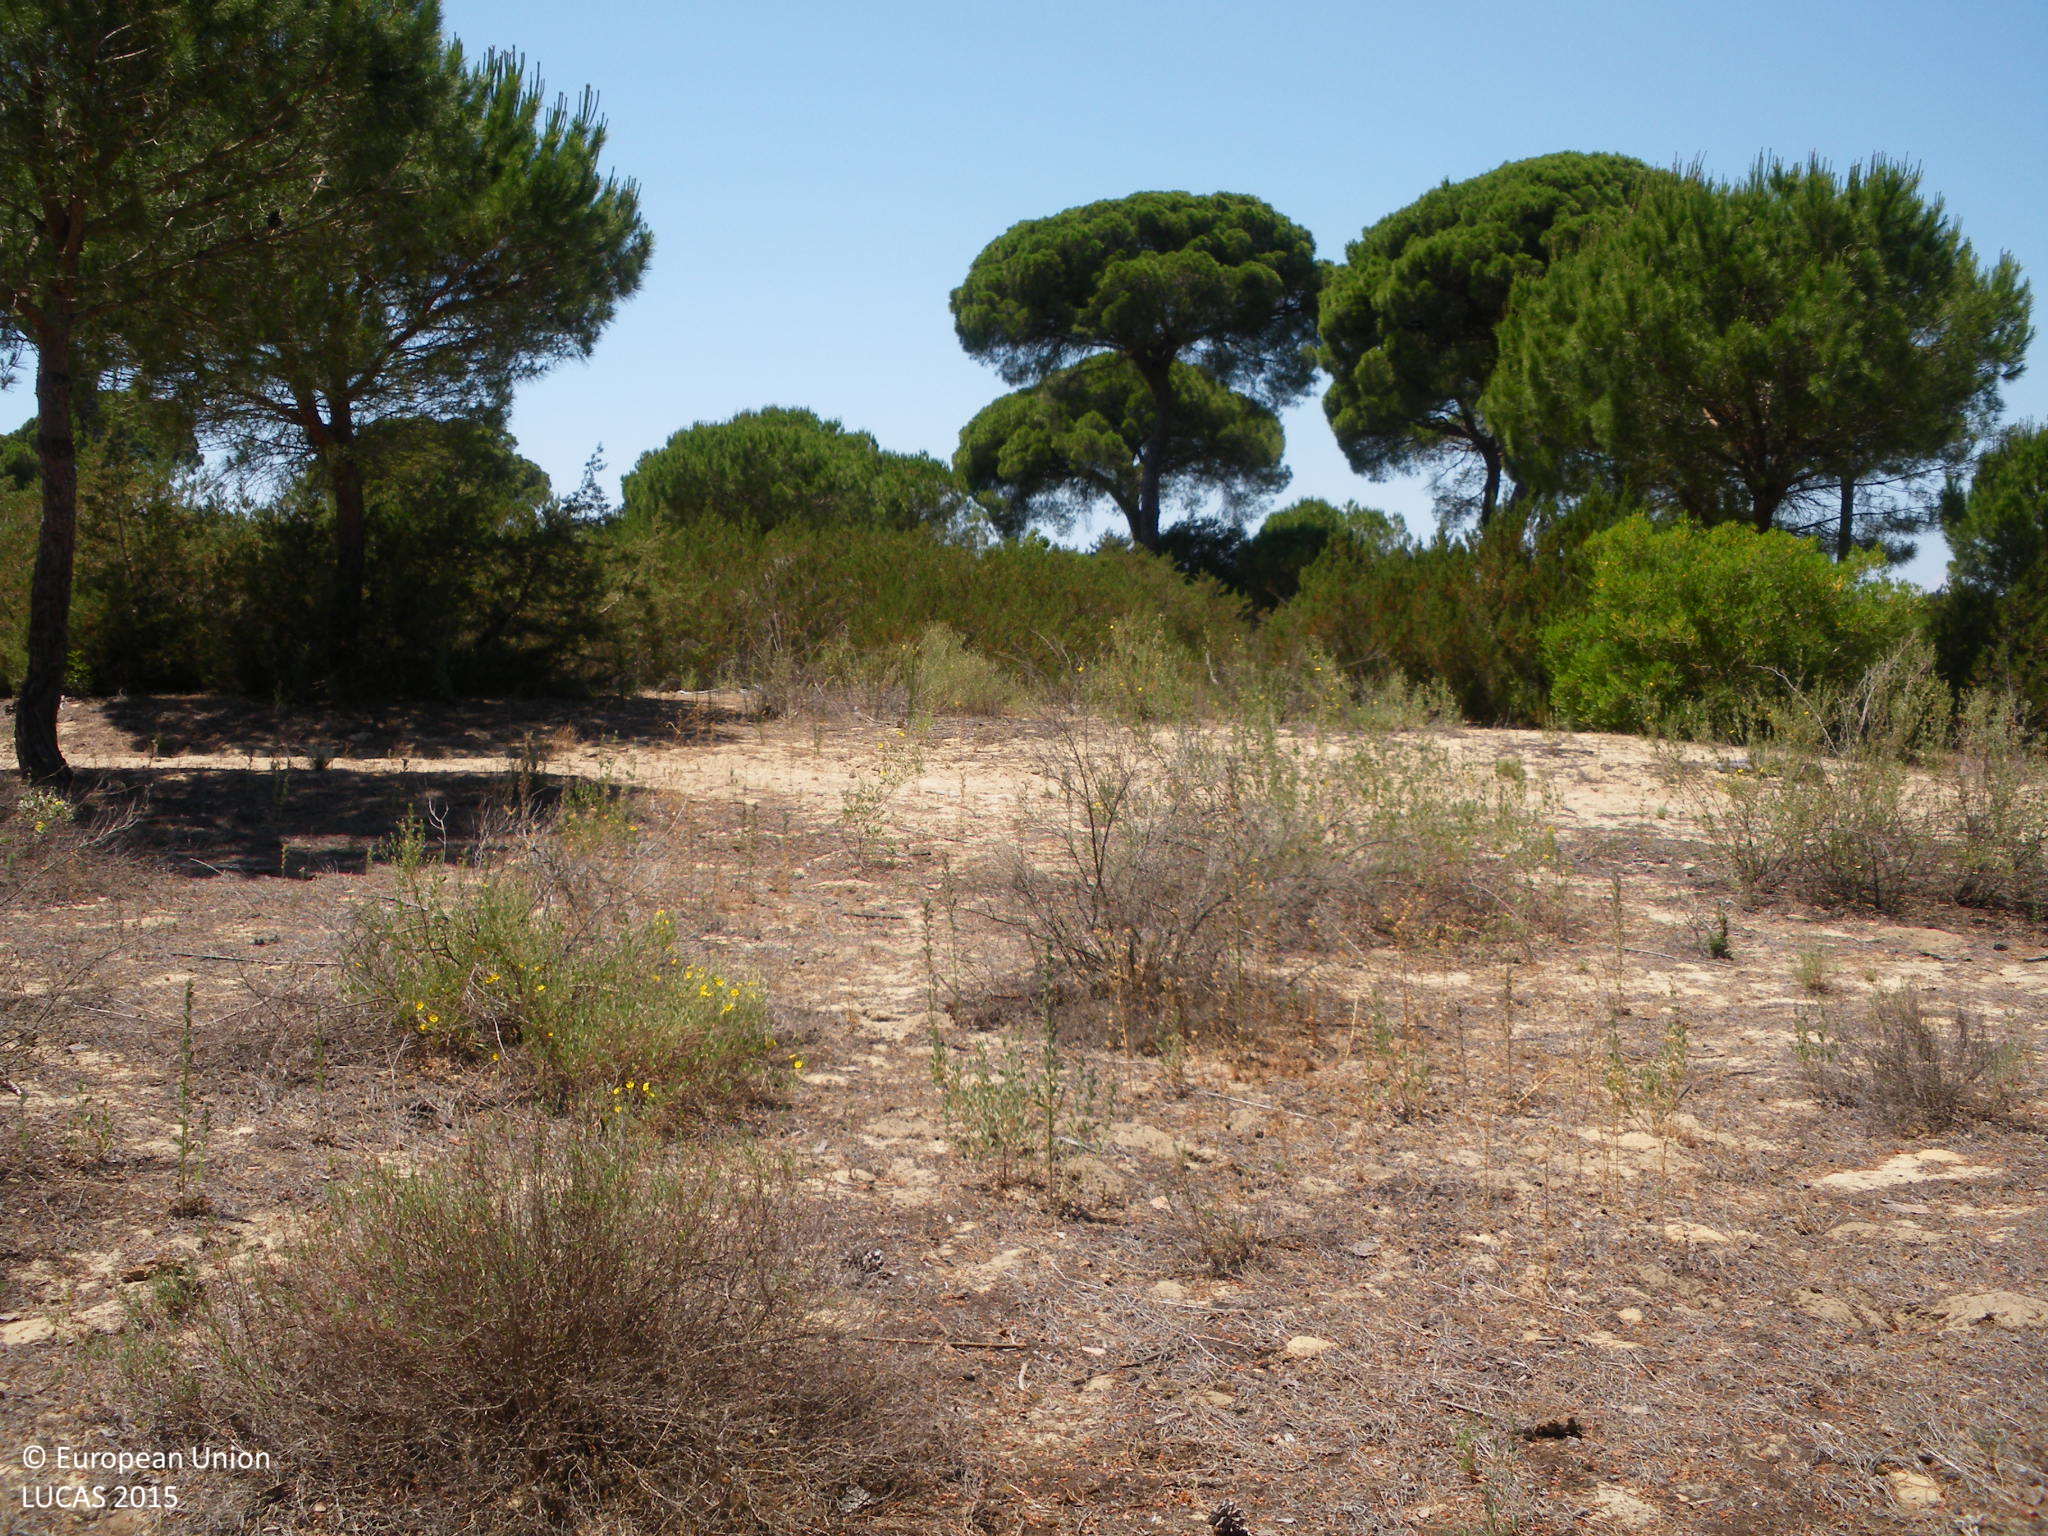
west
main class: Woodland
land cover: Pine dominated coniferous woodland
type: coniferous forest of the mediterranean region
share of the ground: 50 - 75 %
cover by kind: coniferous forest trees 50 %, shrubs 30 %, unconsolidated bare surface 20 %
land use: Forestry
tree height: > 5 m
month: May
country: ES
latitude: 36.8631
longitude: -6.3170
